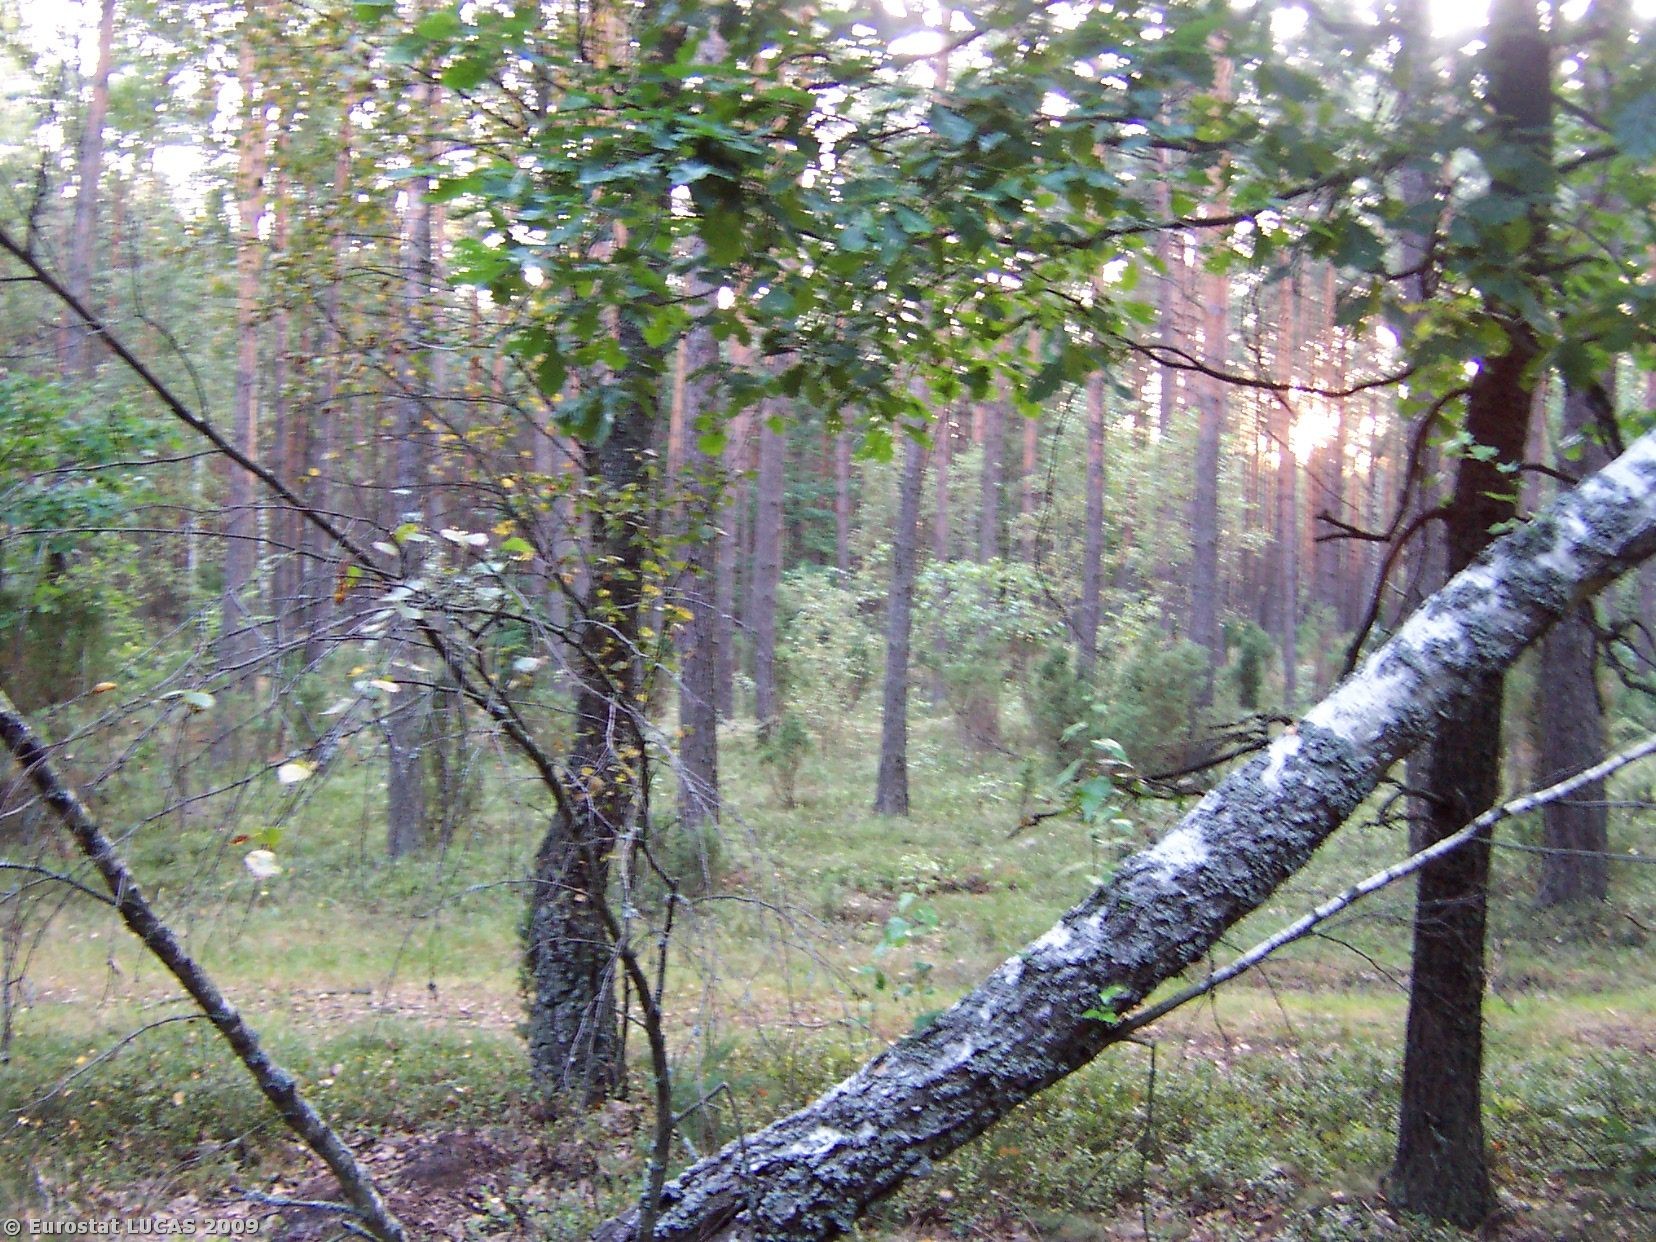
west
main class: Woodland
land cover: Mixed woodland
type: hemiboreal forest and nemoral coniferous forest and mixed broadleaved-coniferous forest
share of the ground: > 75 %
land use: Forestry
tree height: > 5 m
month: August
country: PL
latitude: 52.6994
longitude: 21.7597
